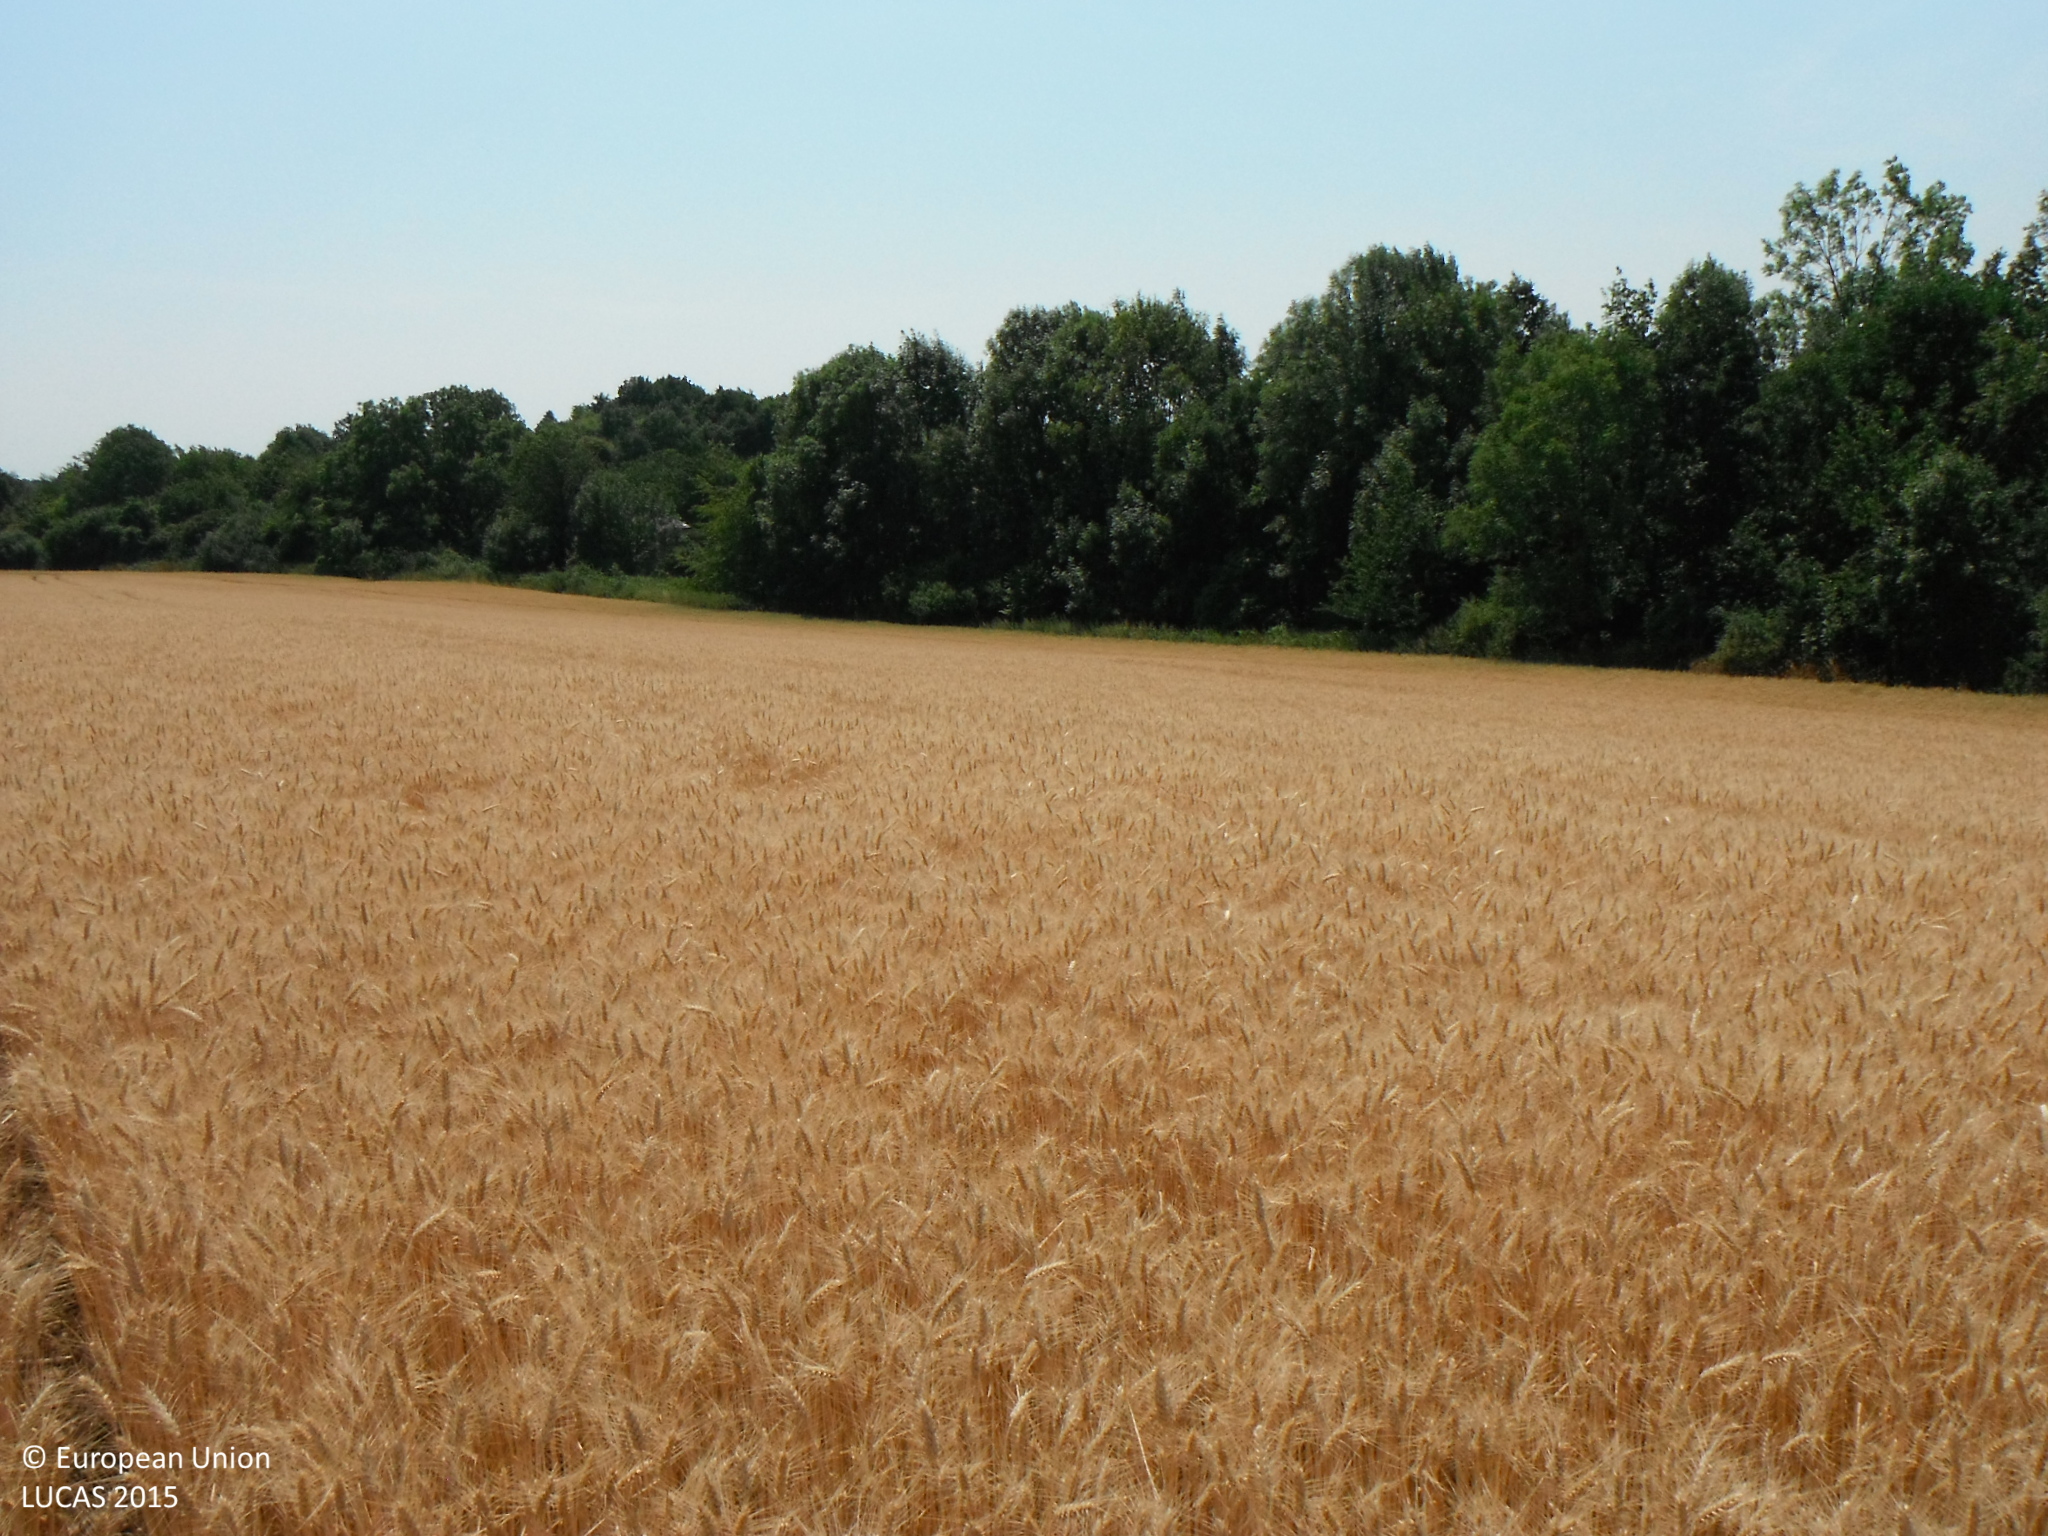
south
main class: Cropland
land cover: Common wheat
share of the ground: > 75 %
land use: Agriculture (excluding fallow land and kitchen gardens)
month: July
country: SK
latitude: 48.2061
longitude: 19.1307
